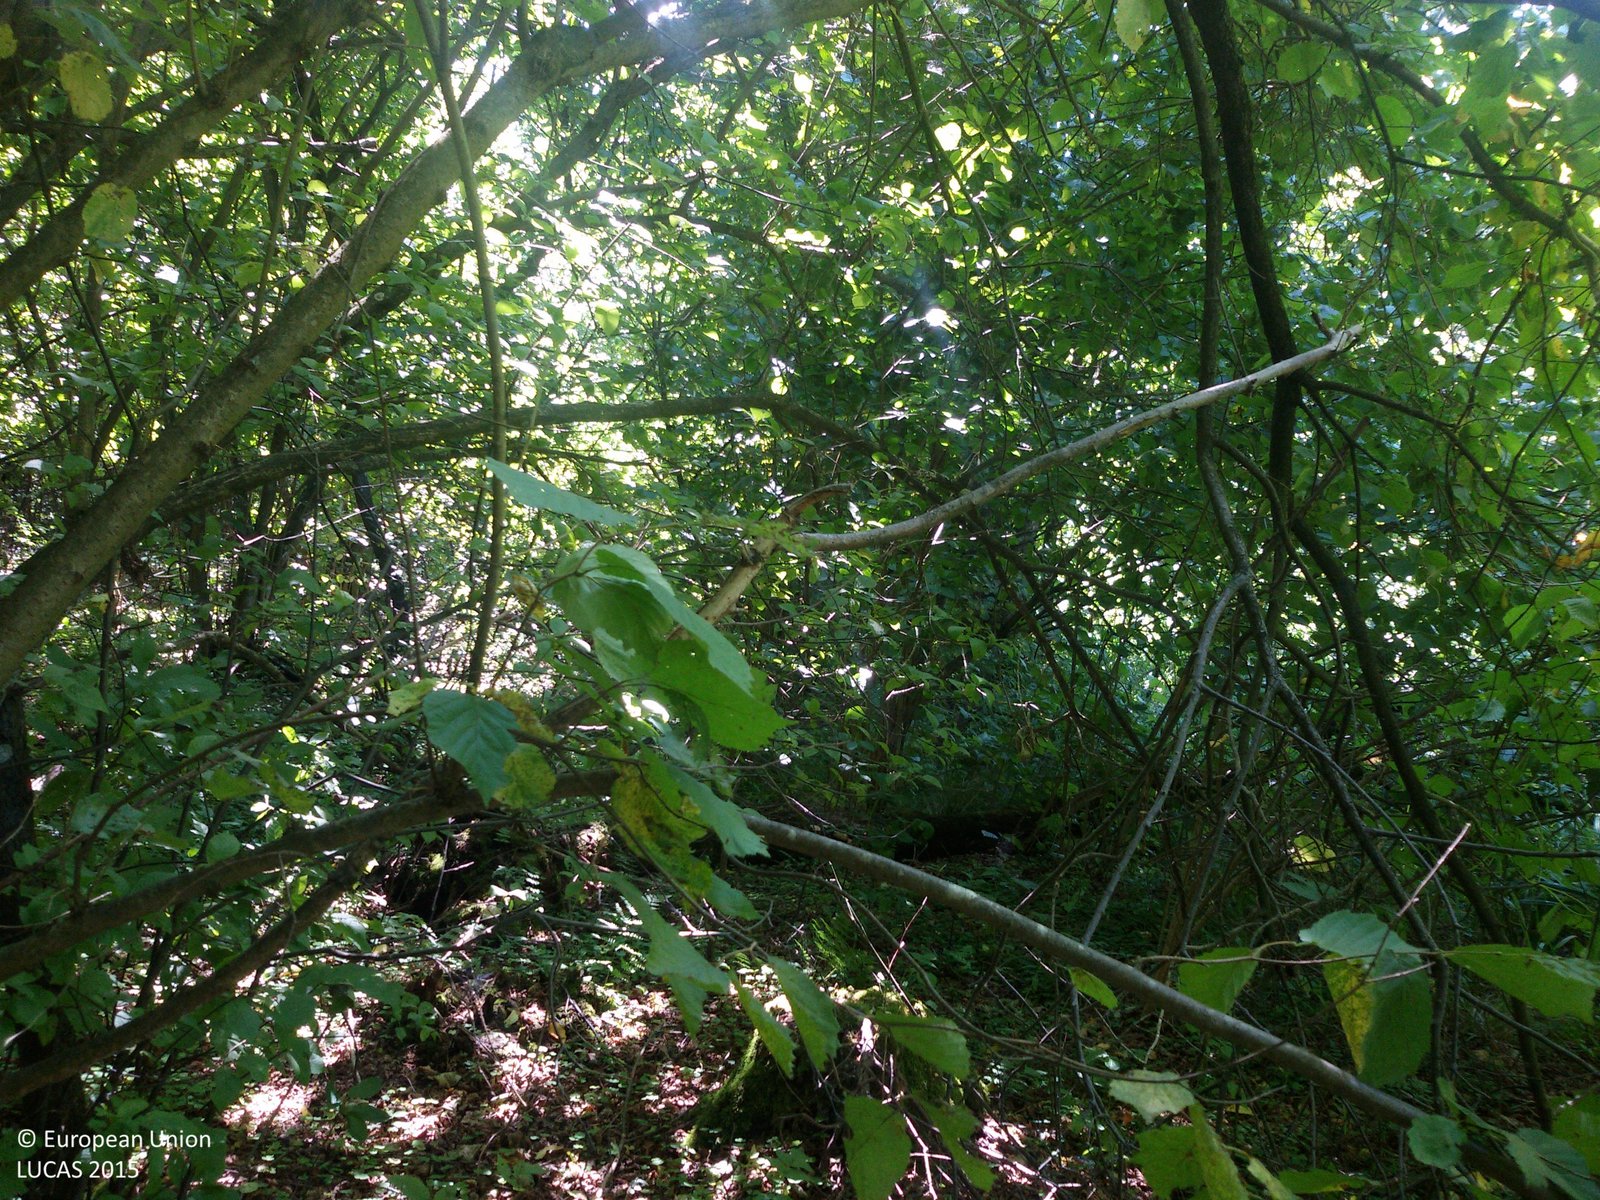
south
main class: Woodland
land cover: Broadleaved woodland
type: mesophytic deciduous forest
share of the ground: > 75 %
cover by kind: broadleaved forest trees 75 %, herbaceous plants 15 %, shrubs 10 %
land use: Forestry
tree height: > 5 m
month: July
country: PL
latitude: 51.5105
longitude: 23.4991
